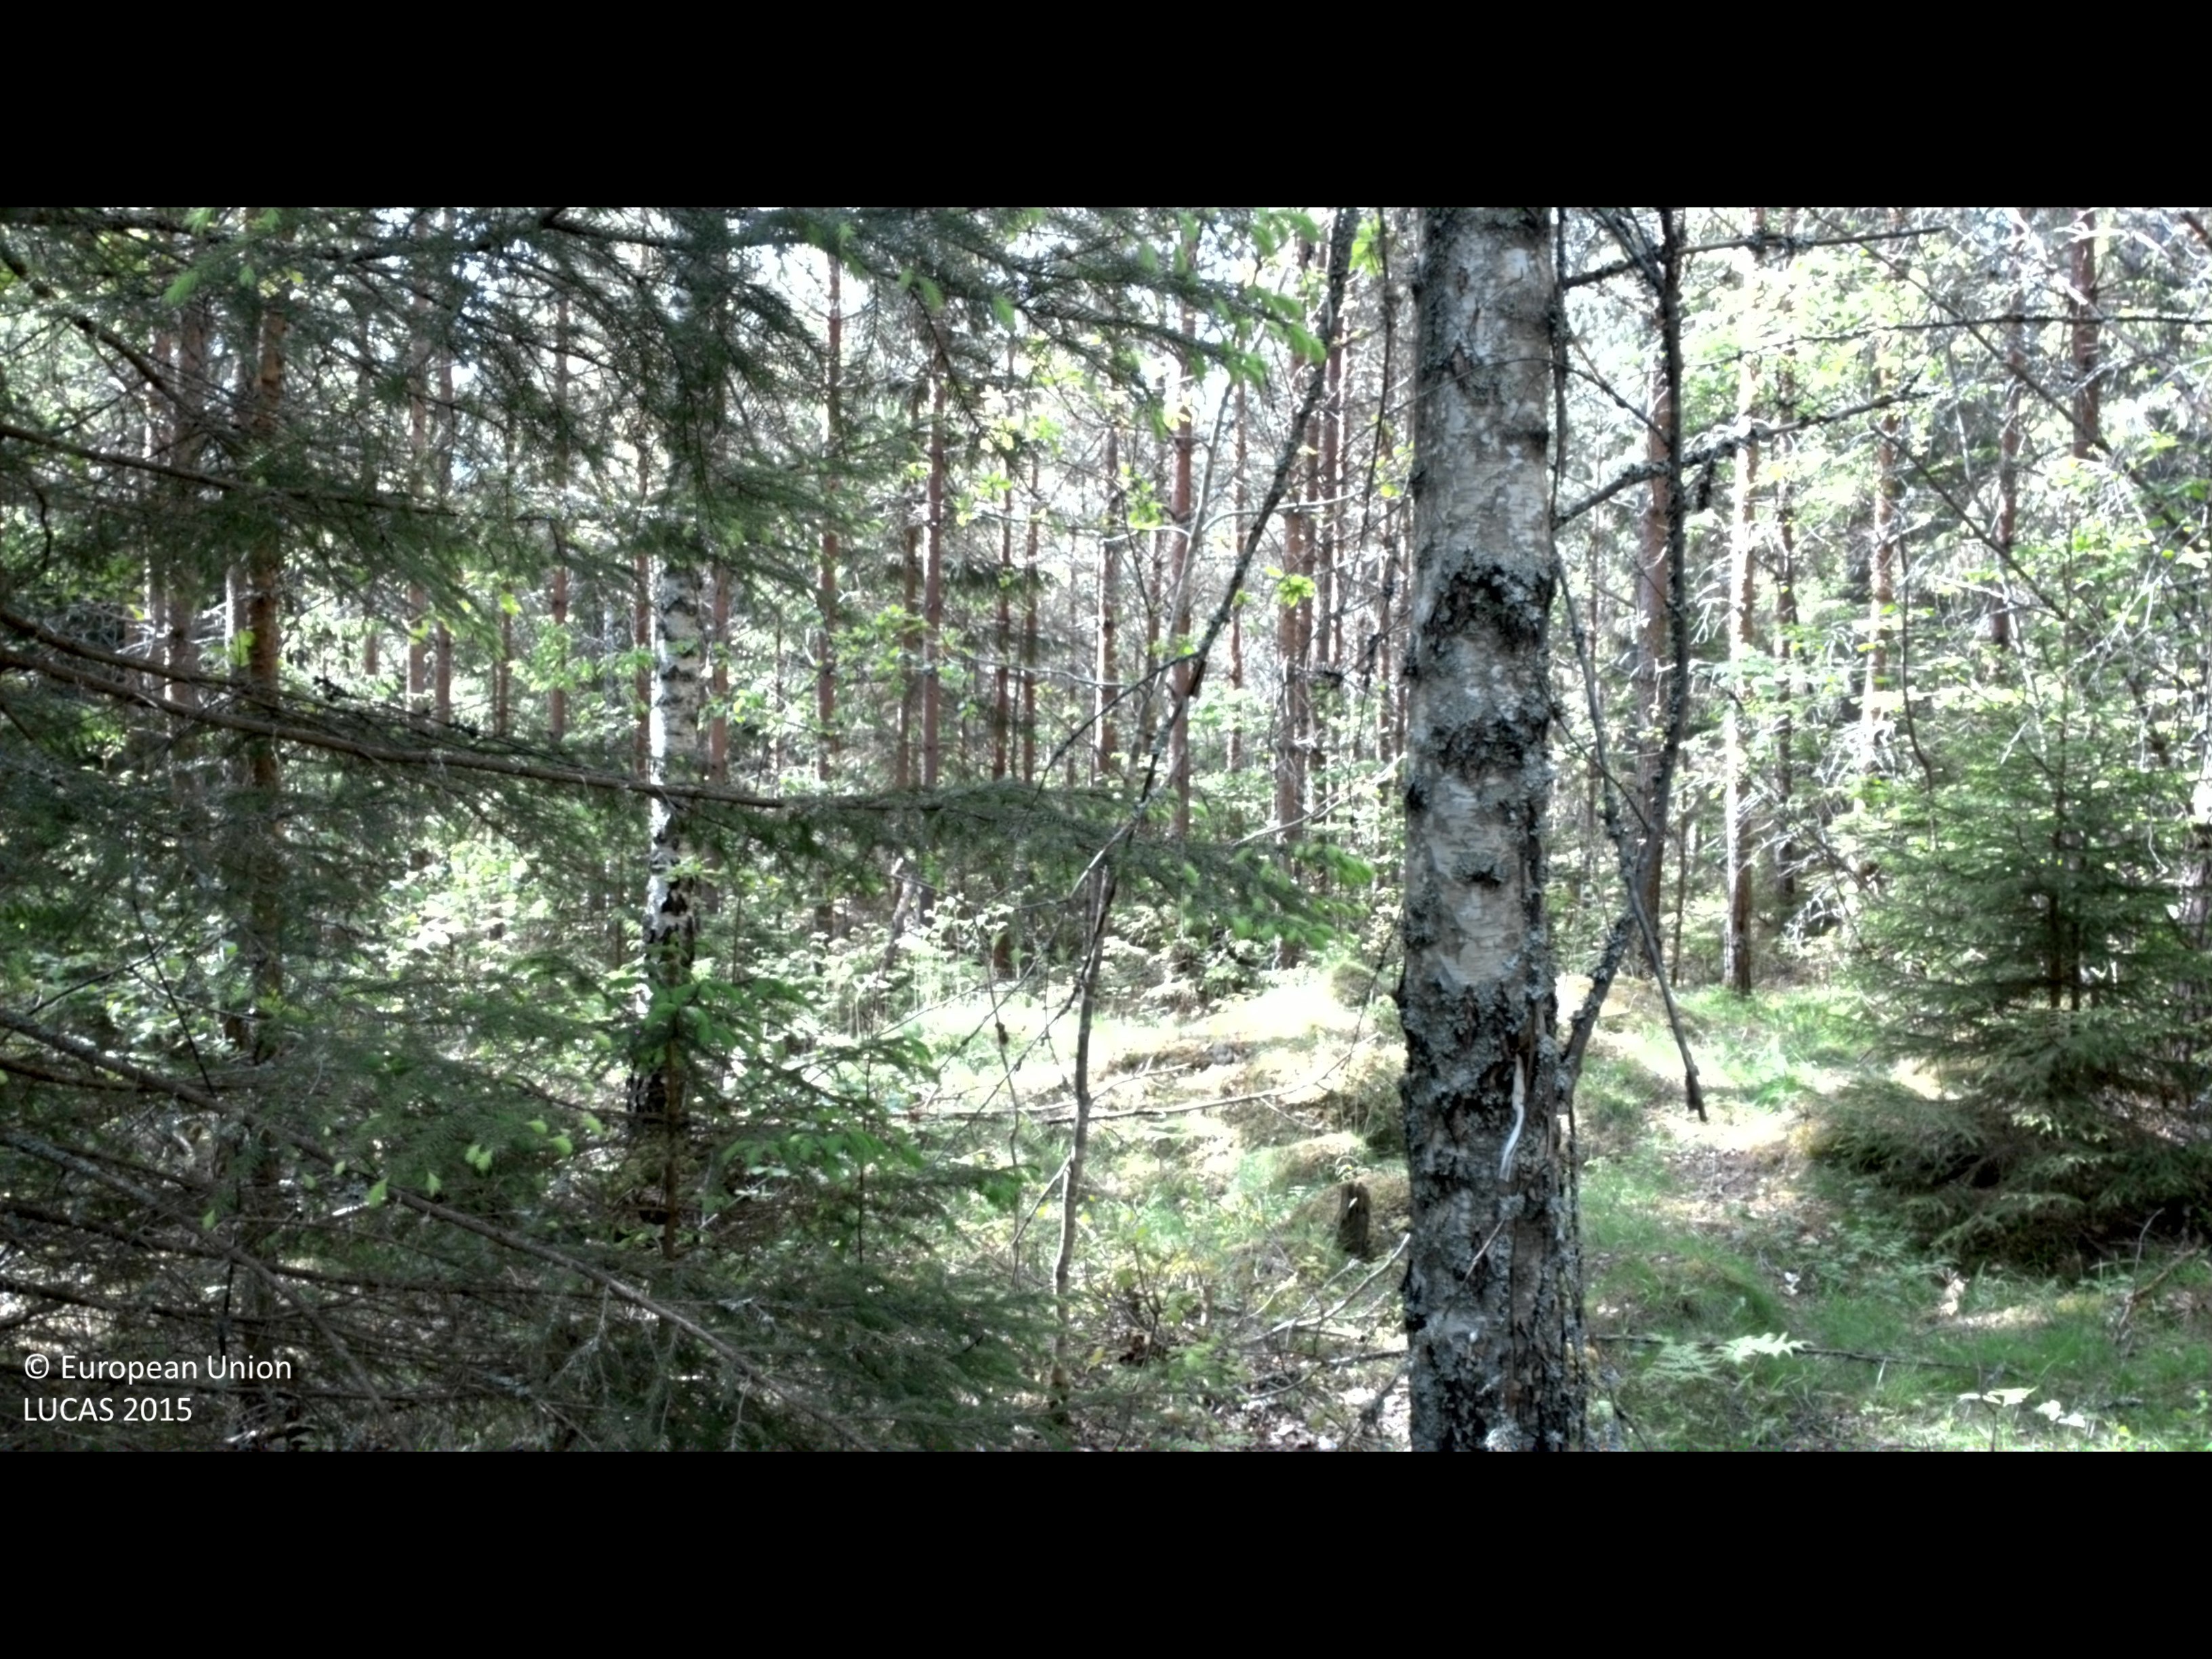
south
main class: Woodland
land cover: Other mixed woodland
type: hemiboreal forest and nemoral coniferous forest and mixed broadleaved-coniferous forest
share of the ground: 50 - 75 %
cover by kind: coniferous forest trees 50 %, broadleaved forest trees 20 %, herbaceous plants 20 %, shrubs 5 %, lichens and mosses 5 %
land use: Forestry
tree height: > 5 m
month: June
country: SE
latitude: 57.8755
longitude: 16.2527
